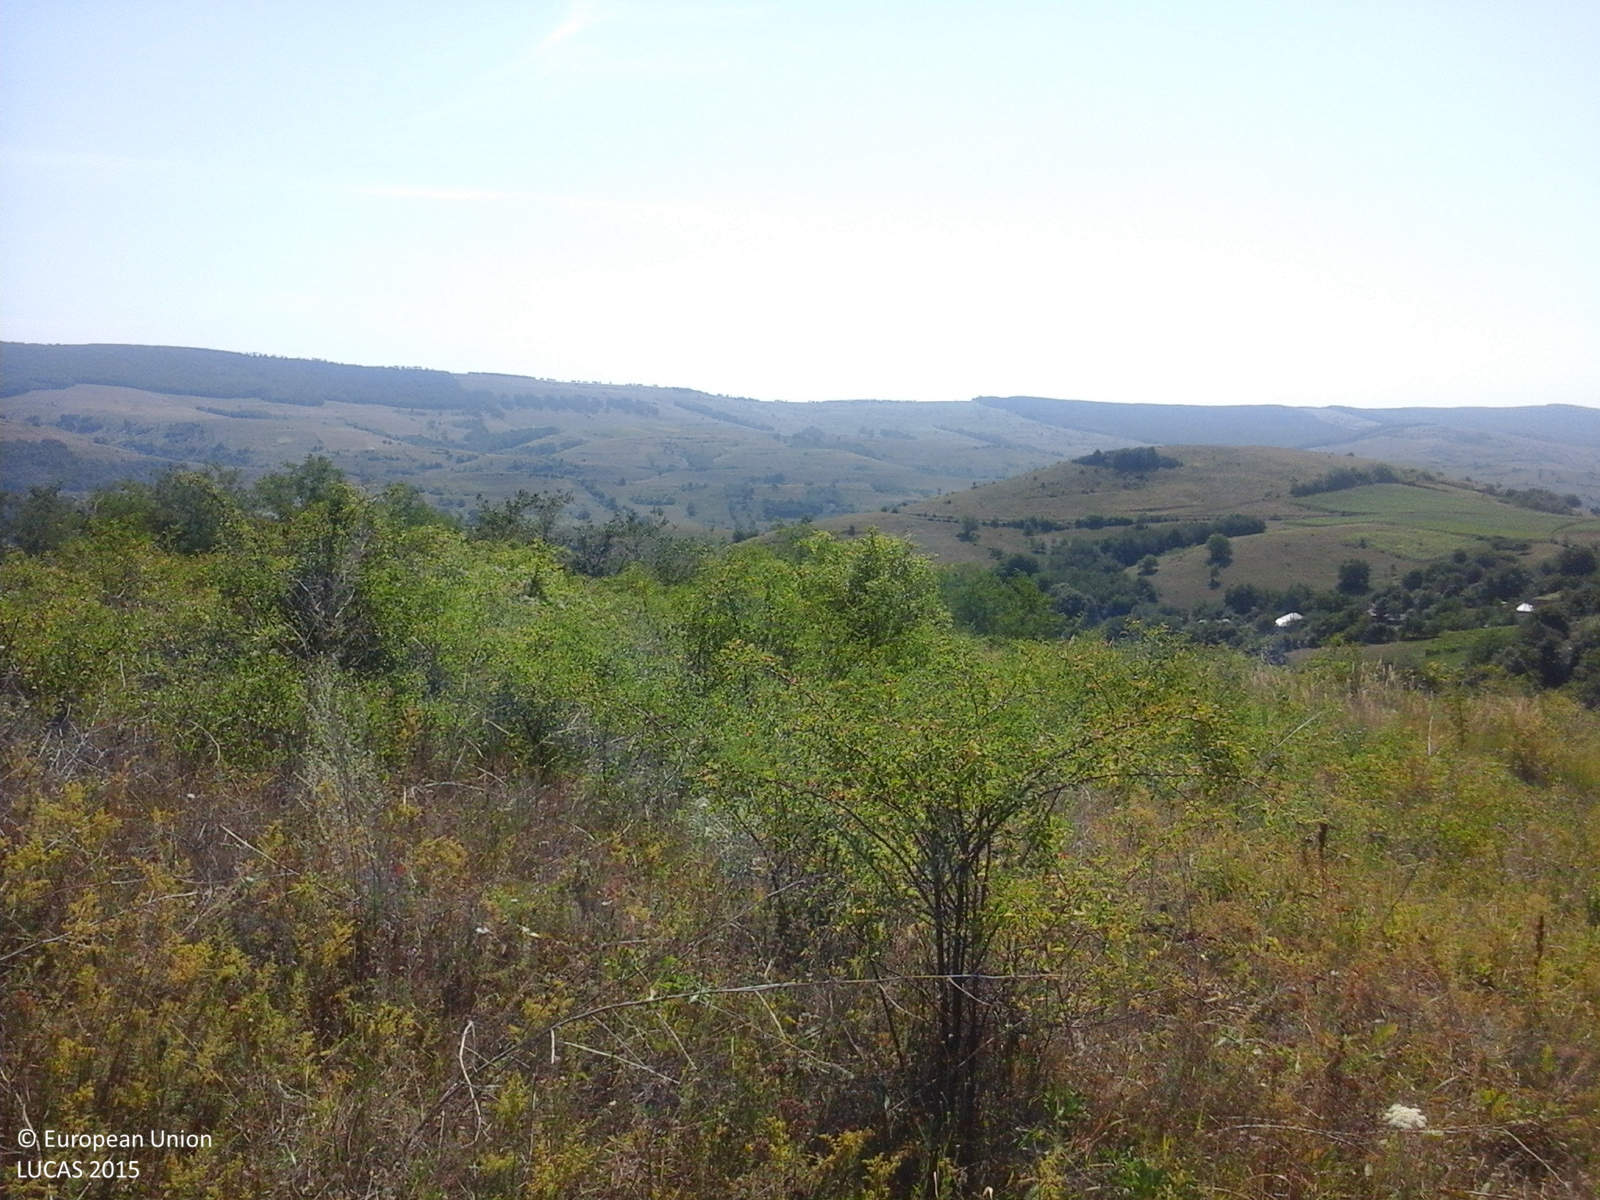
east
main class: Shrubland
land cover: Shrubland with sparse tree cover
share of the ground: > 75 %
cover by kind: shrubs 75 %, herbaceous plants 20 %, broadleaved forest trees 5 %
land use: Semi-natural and natural areas not in use
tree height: > 5 m
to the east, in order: Shrubland with sparse tree cover; Broadleaved woodland; Spontaneously vegetated surfaces; Tracks; Spontaneously vegetated surfaces; Broadleaved woodland; Tracks; Maize
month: July
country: RO
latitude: 46.5412
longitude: 27.2244
